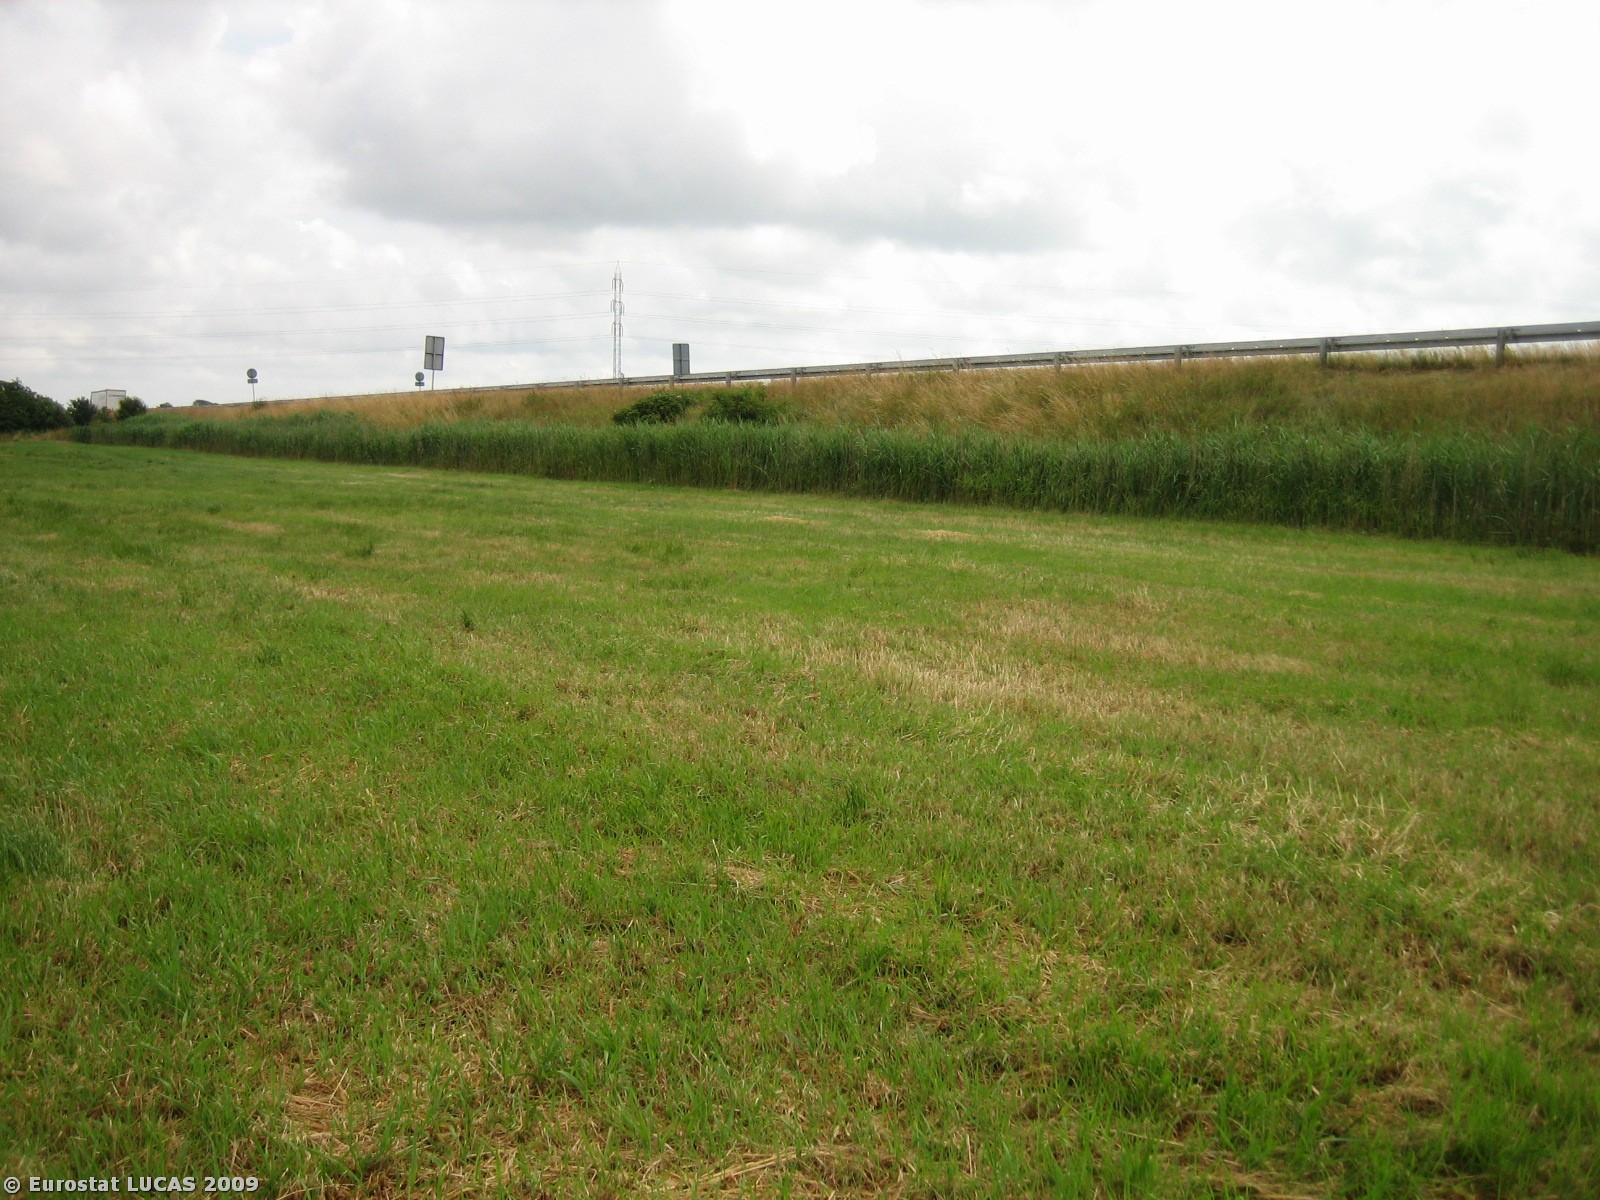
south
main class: Grassland
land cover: Grassland without tree/shrub cover
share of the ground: > 75 %
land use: Agriculture (excluding fallow land and kitchen gardens)
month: July
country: DK
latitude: 55.4606
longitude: 8.5621
